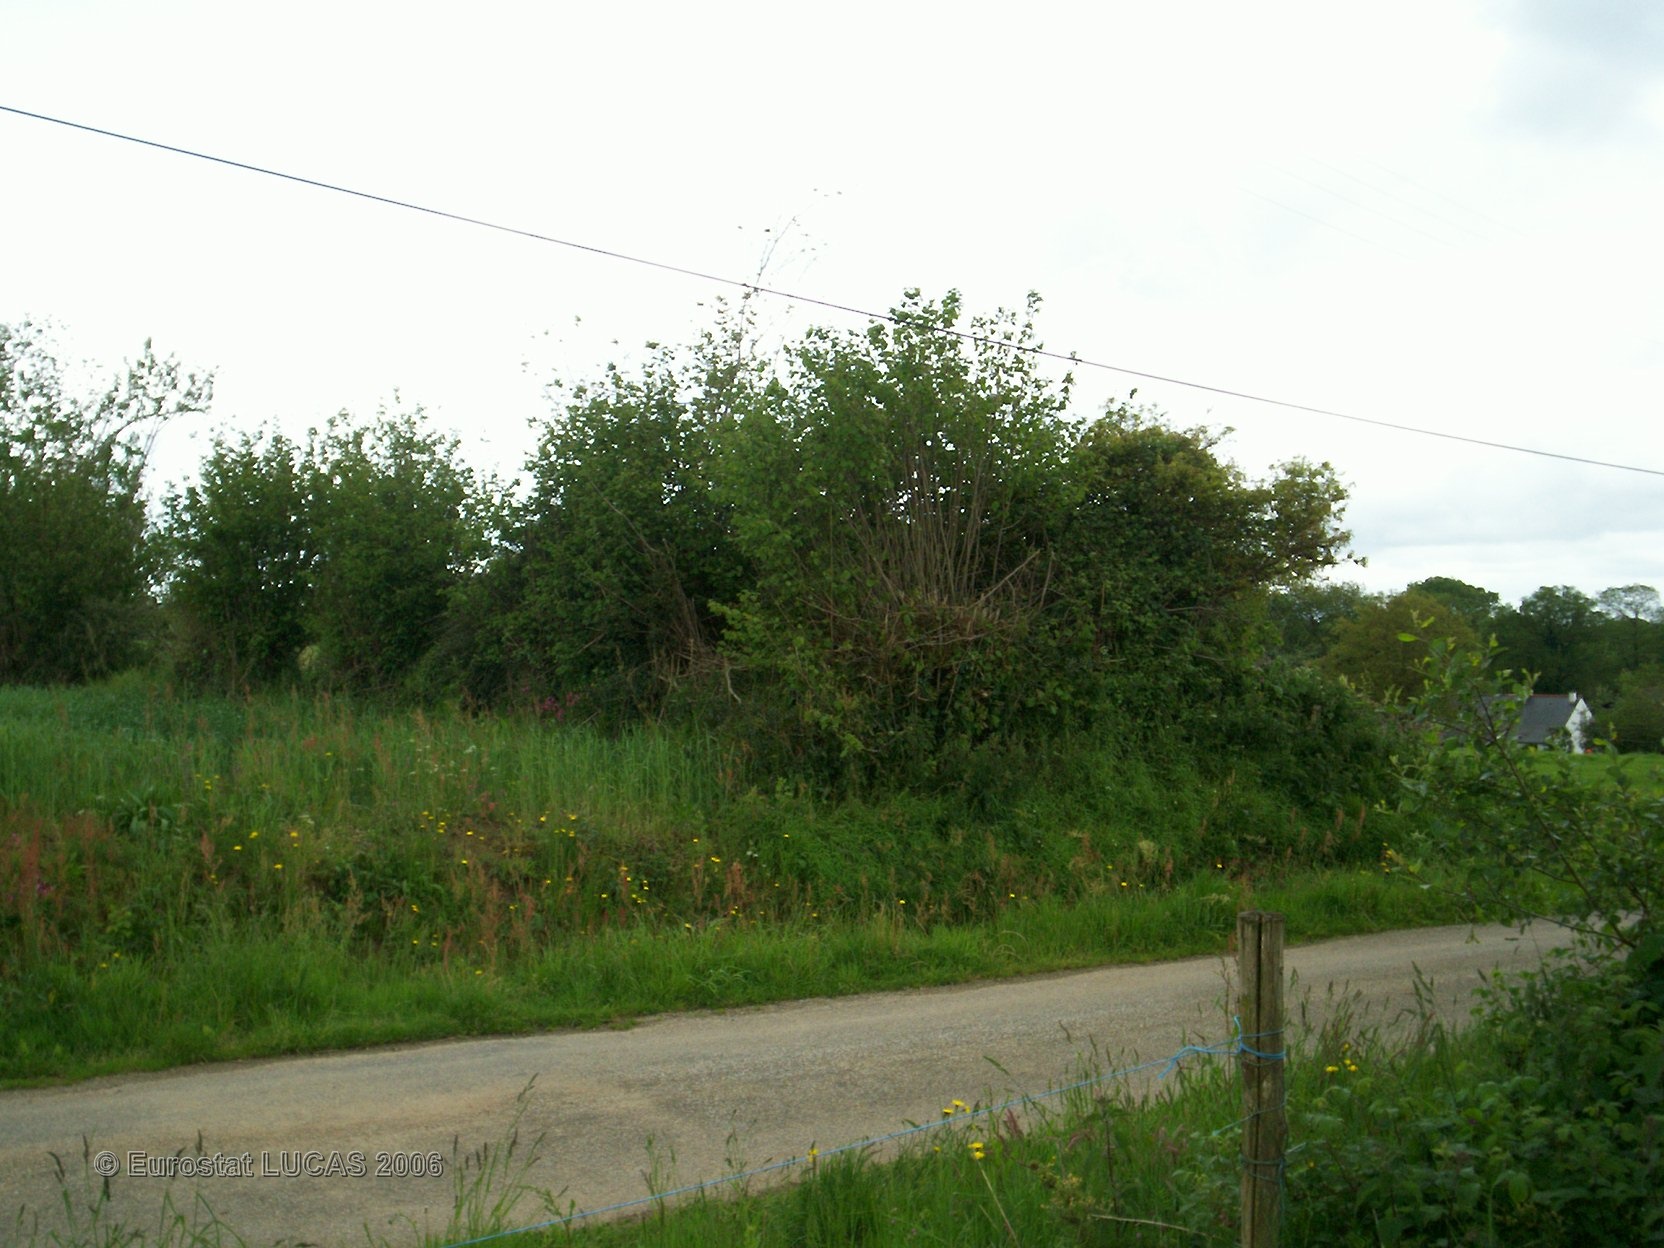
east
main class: Cropland
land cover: Common wheat
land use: Agriculture (excluding fallow land and kitchen gardens)
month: May
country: FR
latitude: 48.0733
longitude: -3.5669
